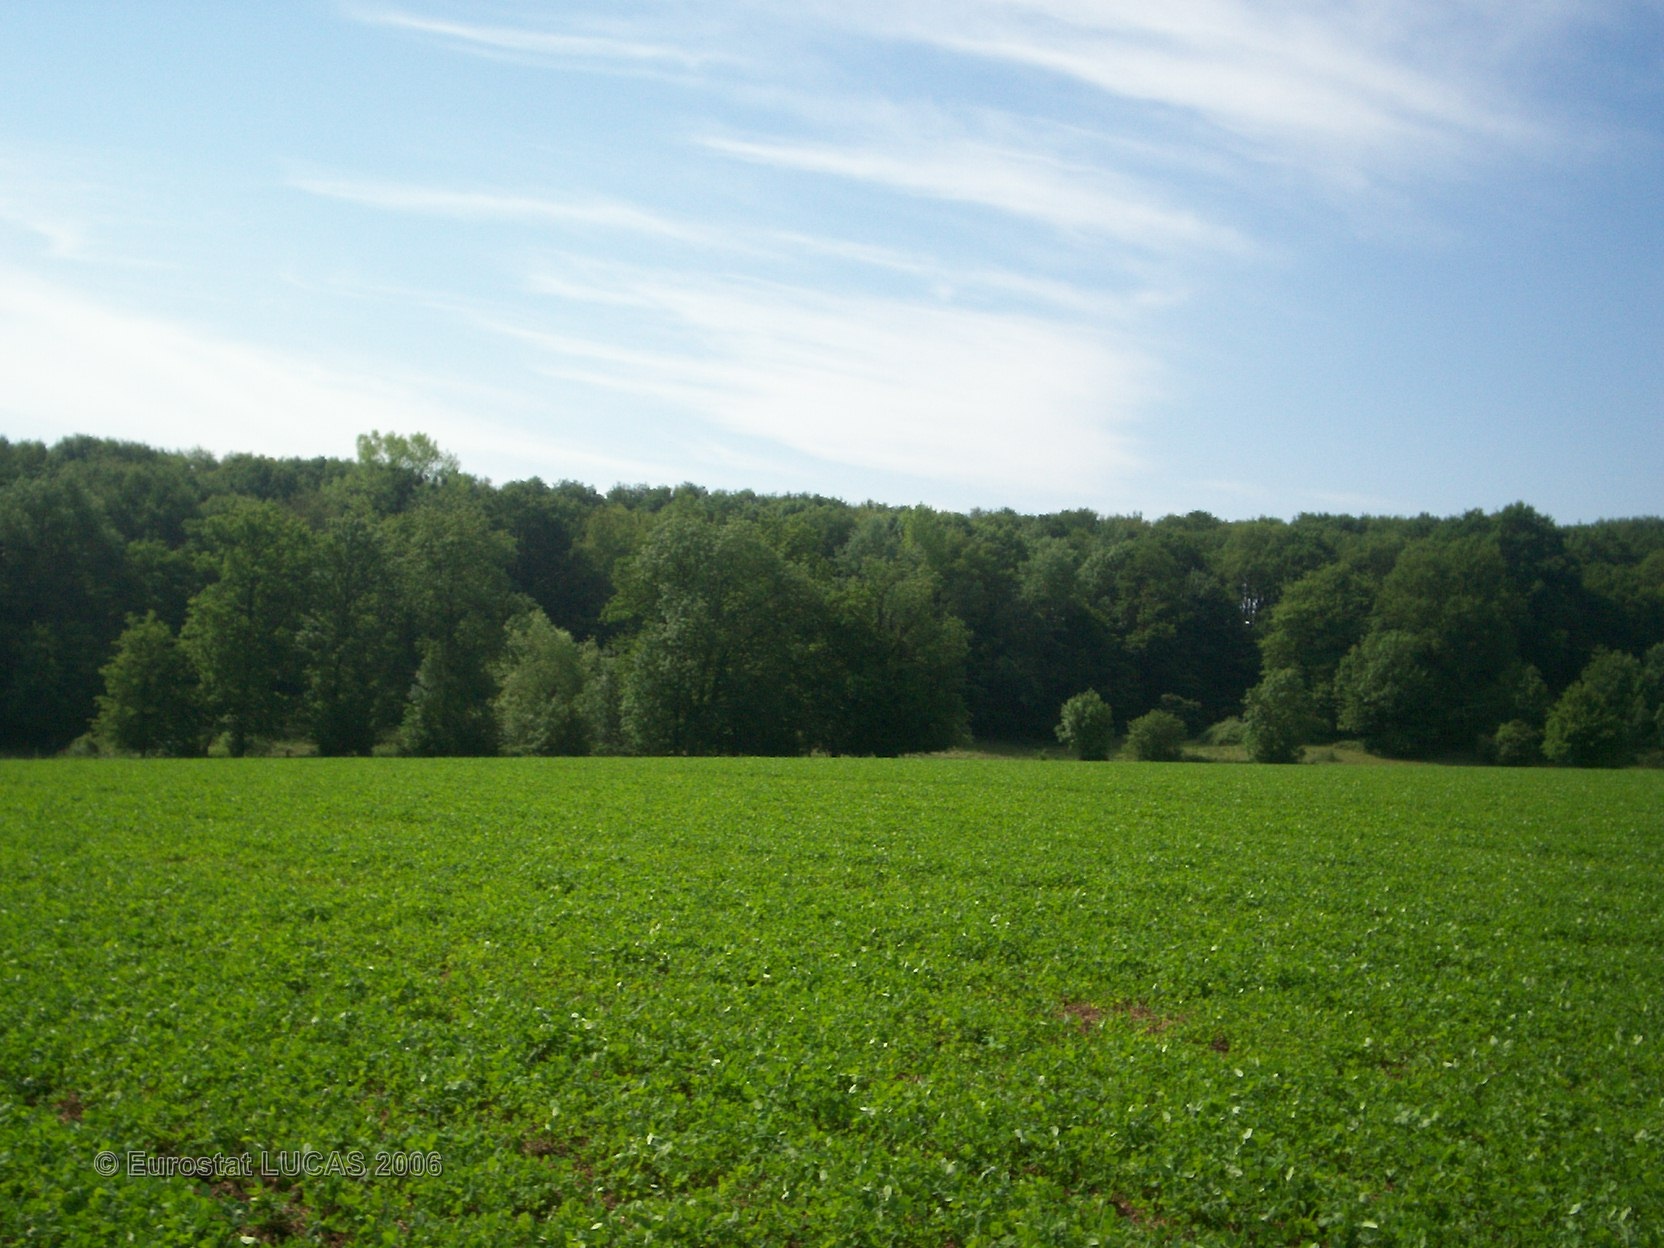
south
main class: Cropland
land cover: Clovers
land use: Agriculture (excluding fallow land and kitchen gardens)
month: June
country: FR
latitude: 49.5889
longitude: 2.6989
